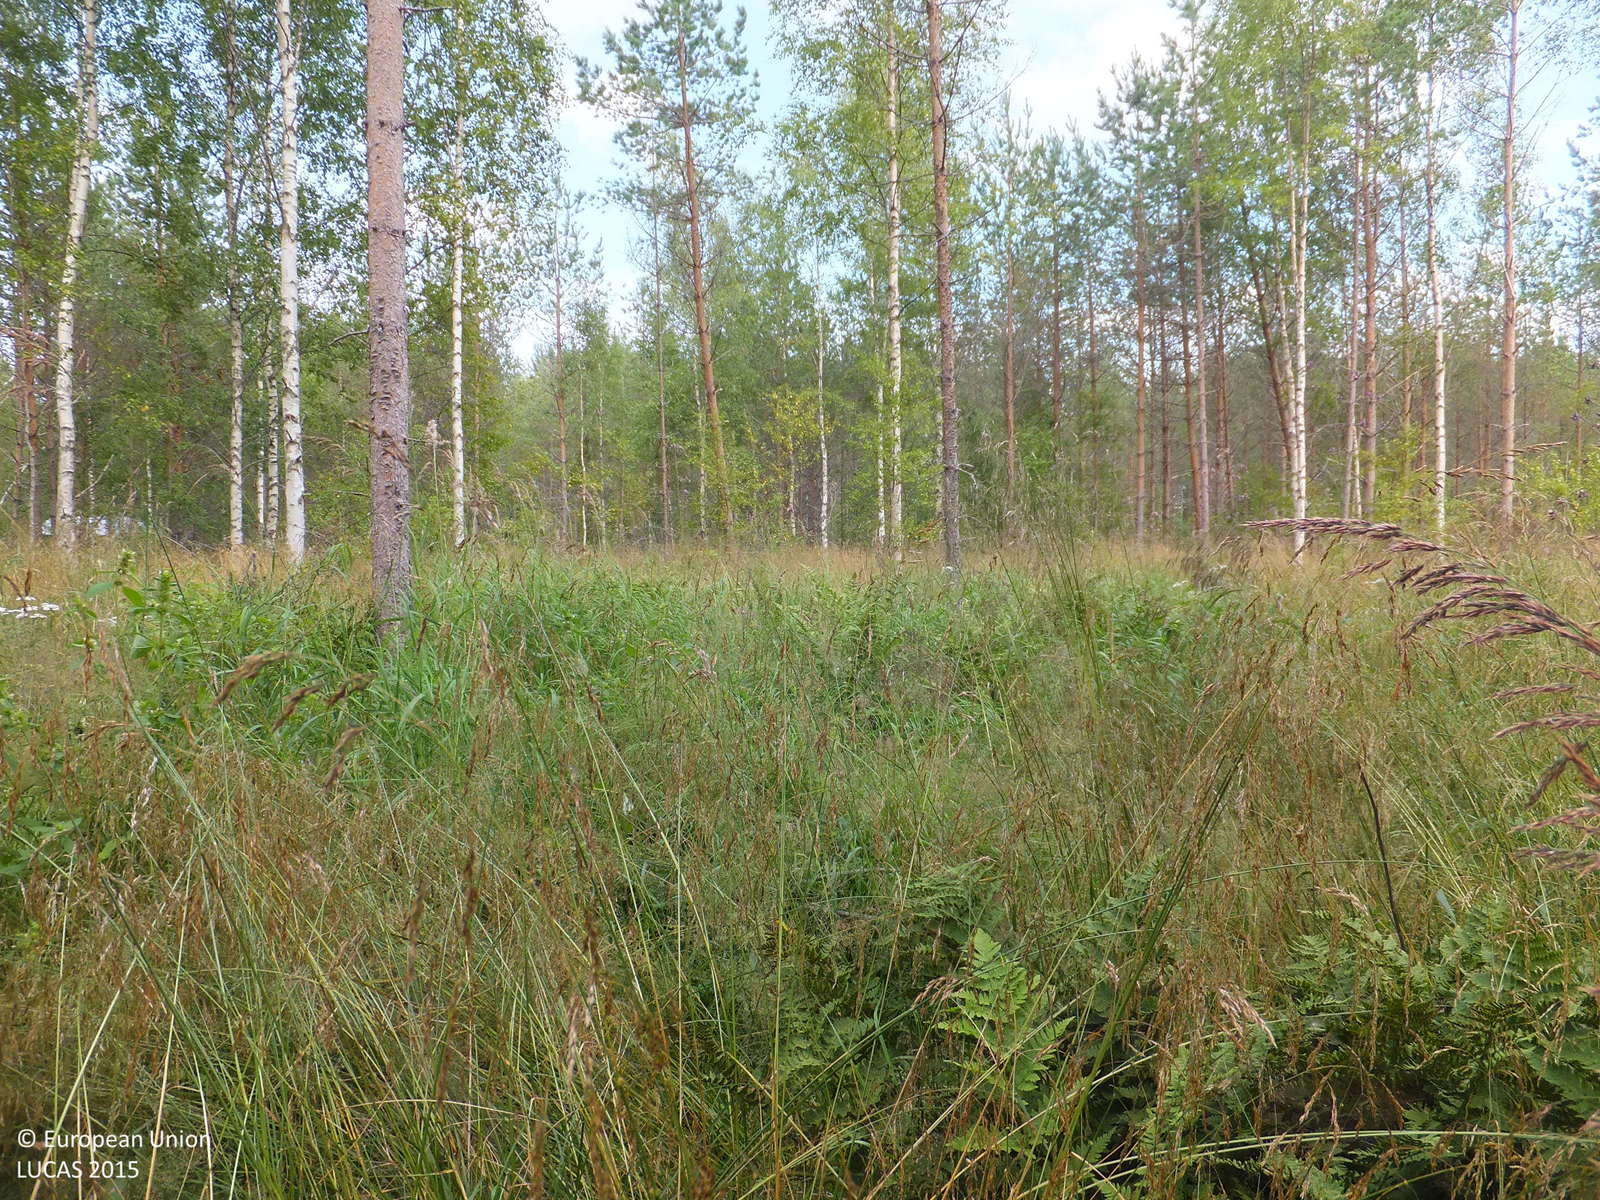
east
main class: Woodland
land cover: Pine dominated coniferous woodland
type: mire and swamp forests
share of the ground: > 75 %
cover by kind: coniferous forest trees 70 %, shrubs 15 %, broadleaved forest trees 5 %, herbaceous plants 5 %, lichens and mosses 5 %
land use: Forestry
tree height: > 5 m
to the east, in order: Pine dominated coniferous woodland; Ditches and canals; Pine dominated coniferous woodland; Pine dominated mixed woodland; Ditches and canals; Grassland without tree/shrub cover; Pine dominated mixed woodland; Broadleaved woodland; Ditches and canals; Broadleaved woodland
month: August
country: FI
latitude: 63.1946
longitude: 22.6333
